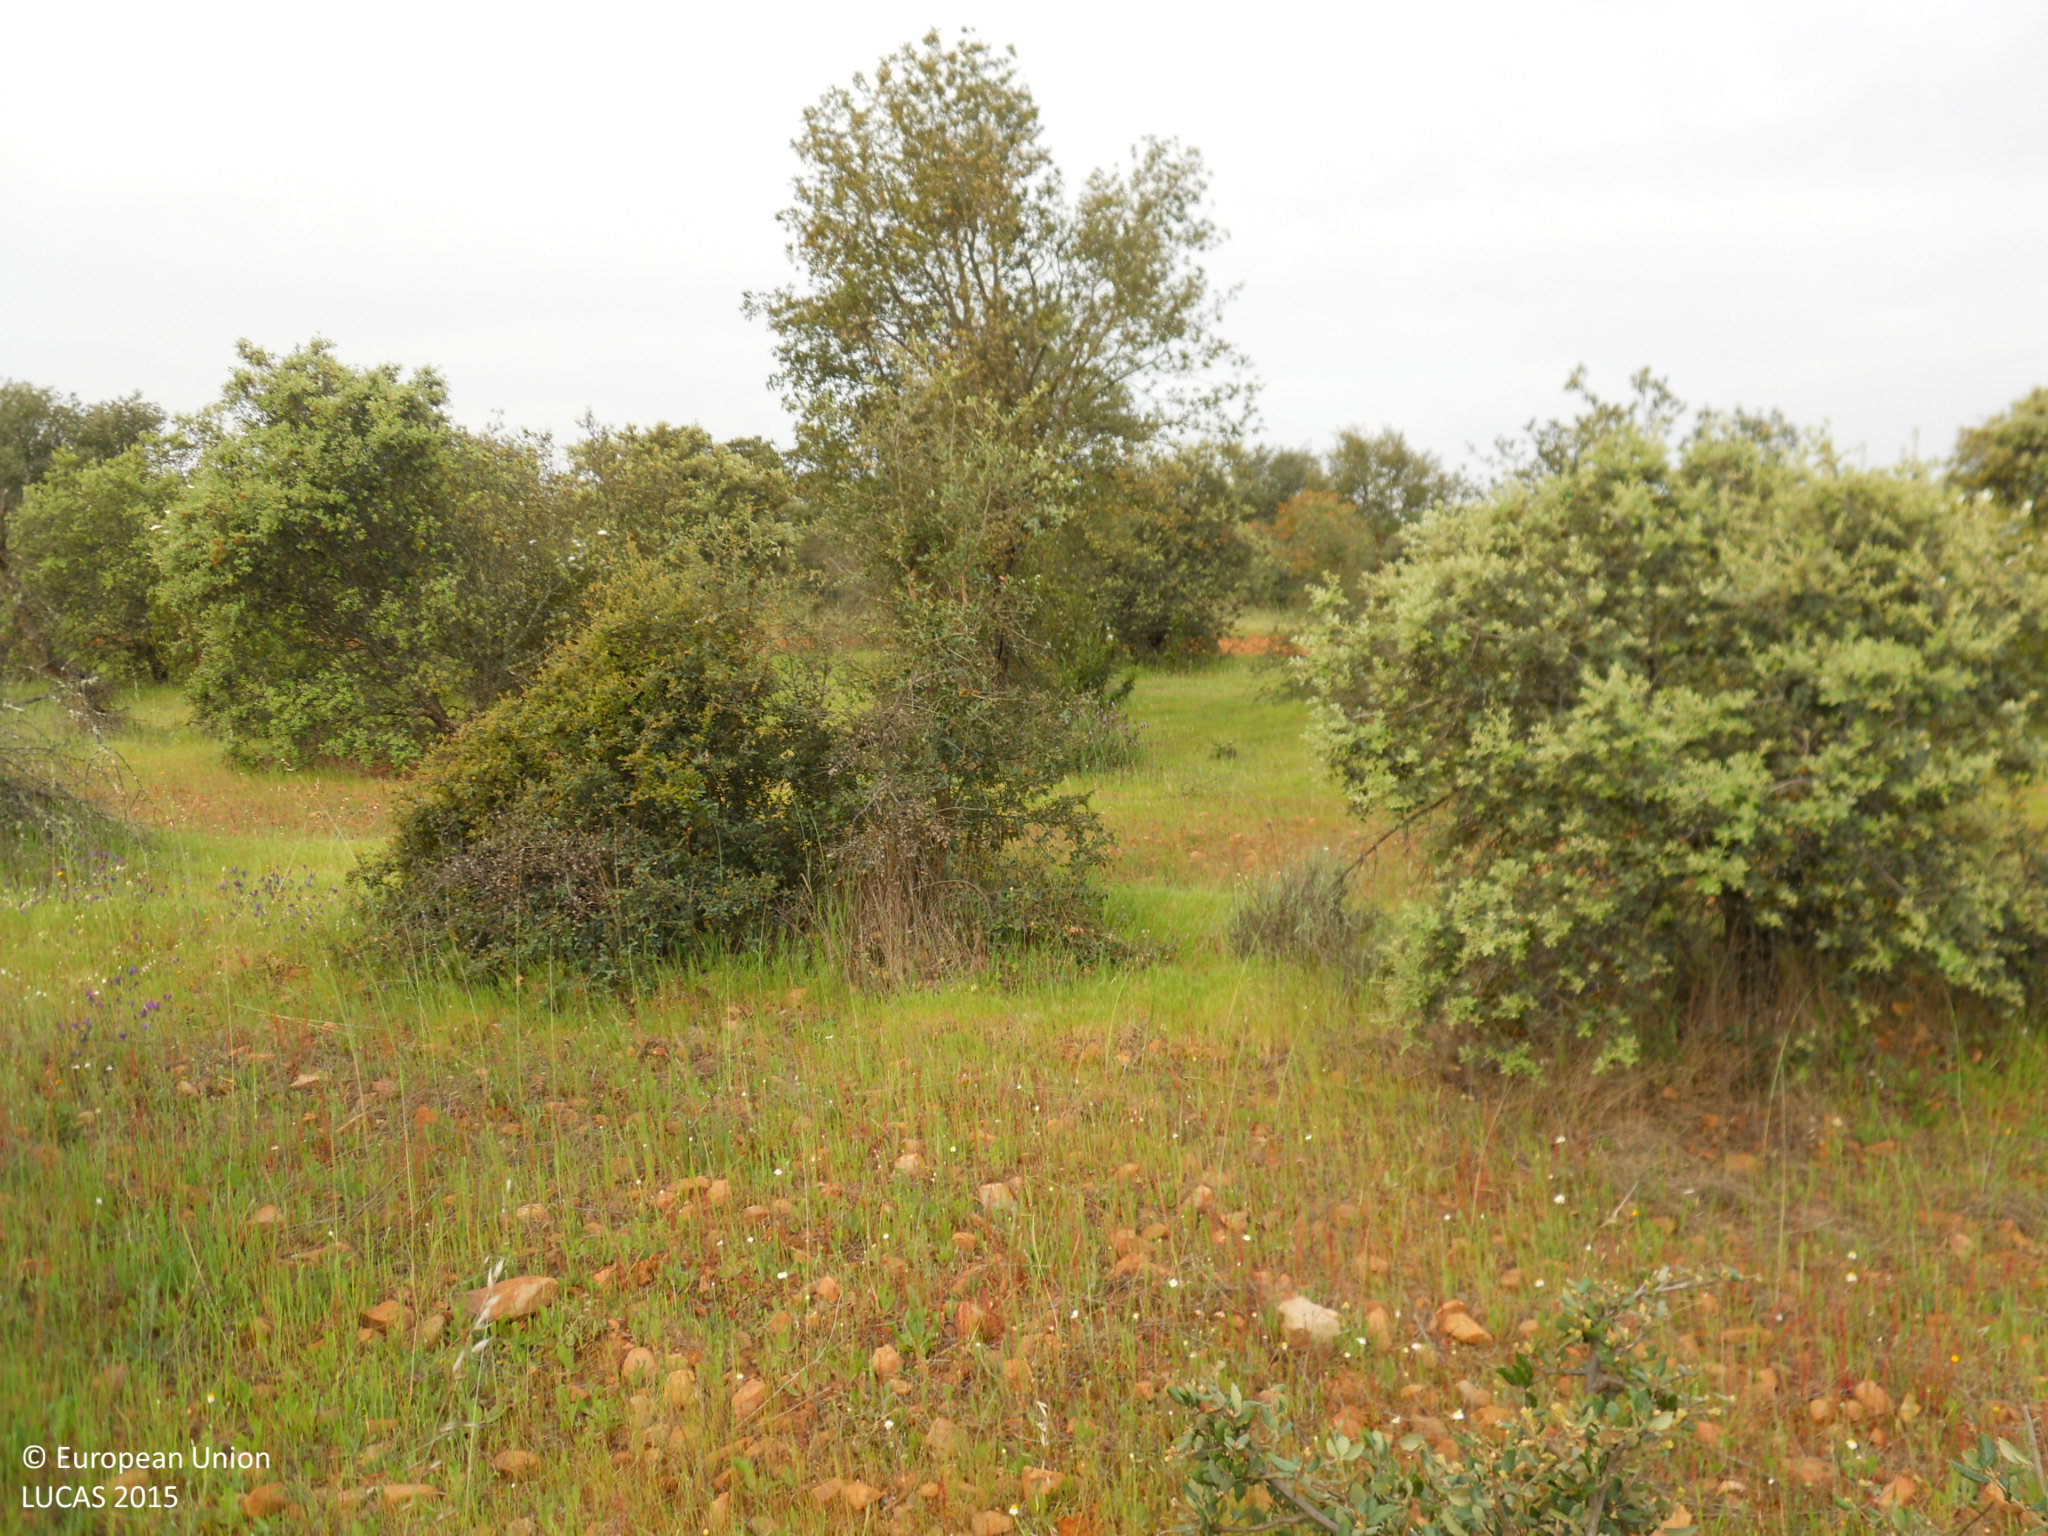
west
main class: Woodland
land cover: Broadleaved woodland
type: broadleaved evergreen forest
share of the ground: > 75 %
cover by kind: broadleaved forest trees 40 %, unconsolidated bare surface 40 %, shrubs 20 %
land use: Forestry
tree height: < 5 m
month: April
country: ES
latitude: 39.1096
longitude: -6.5446
